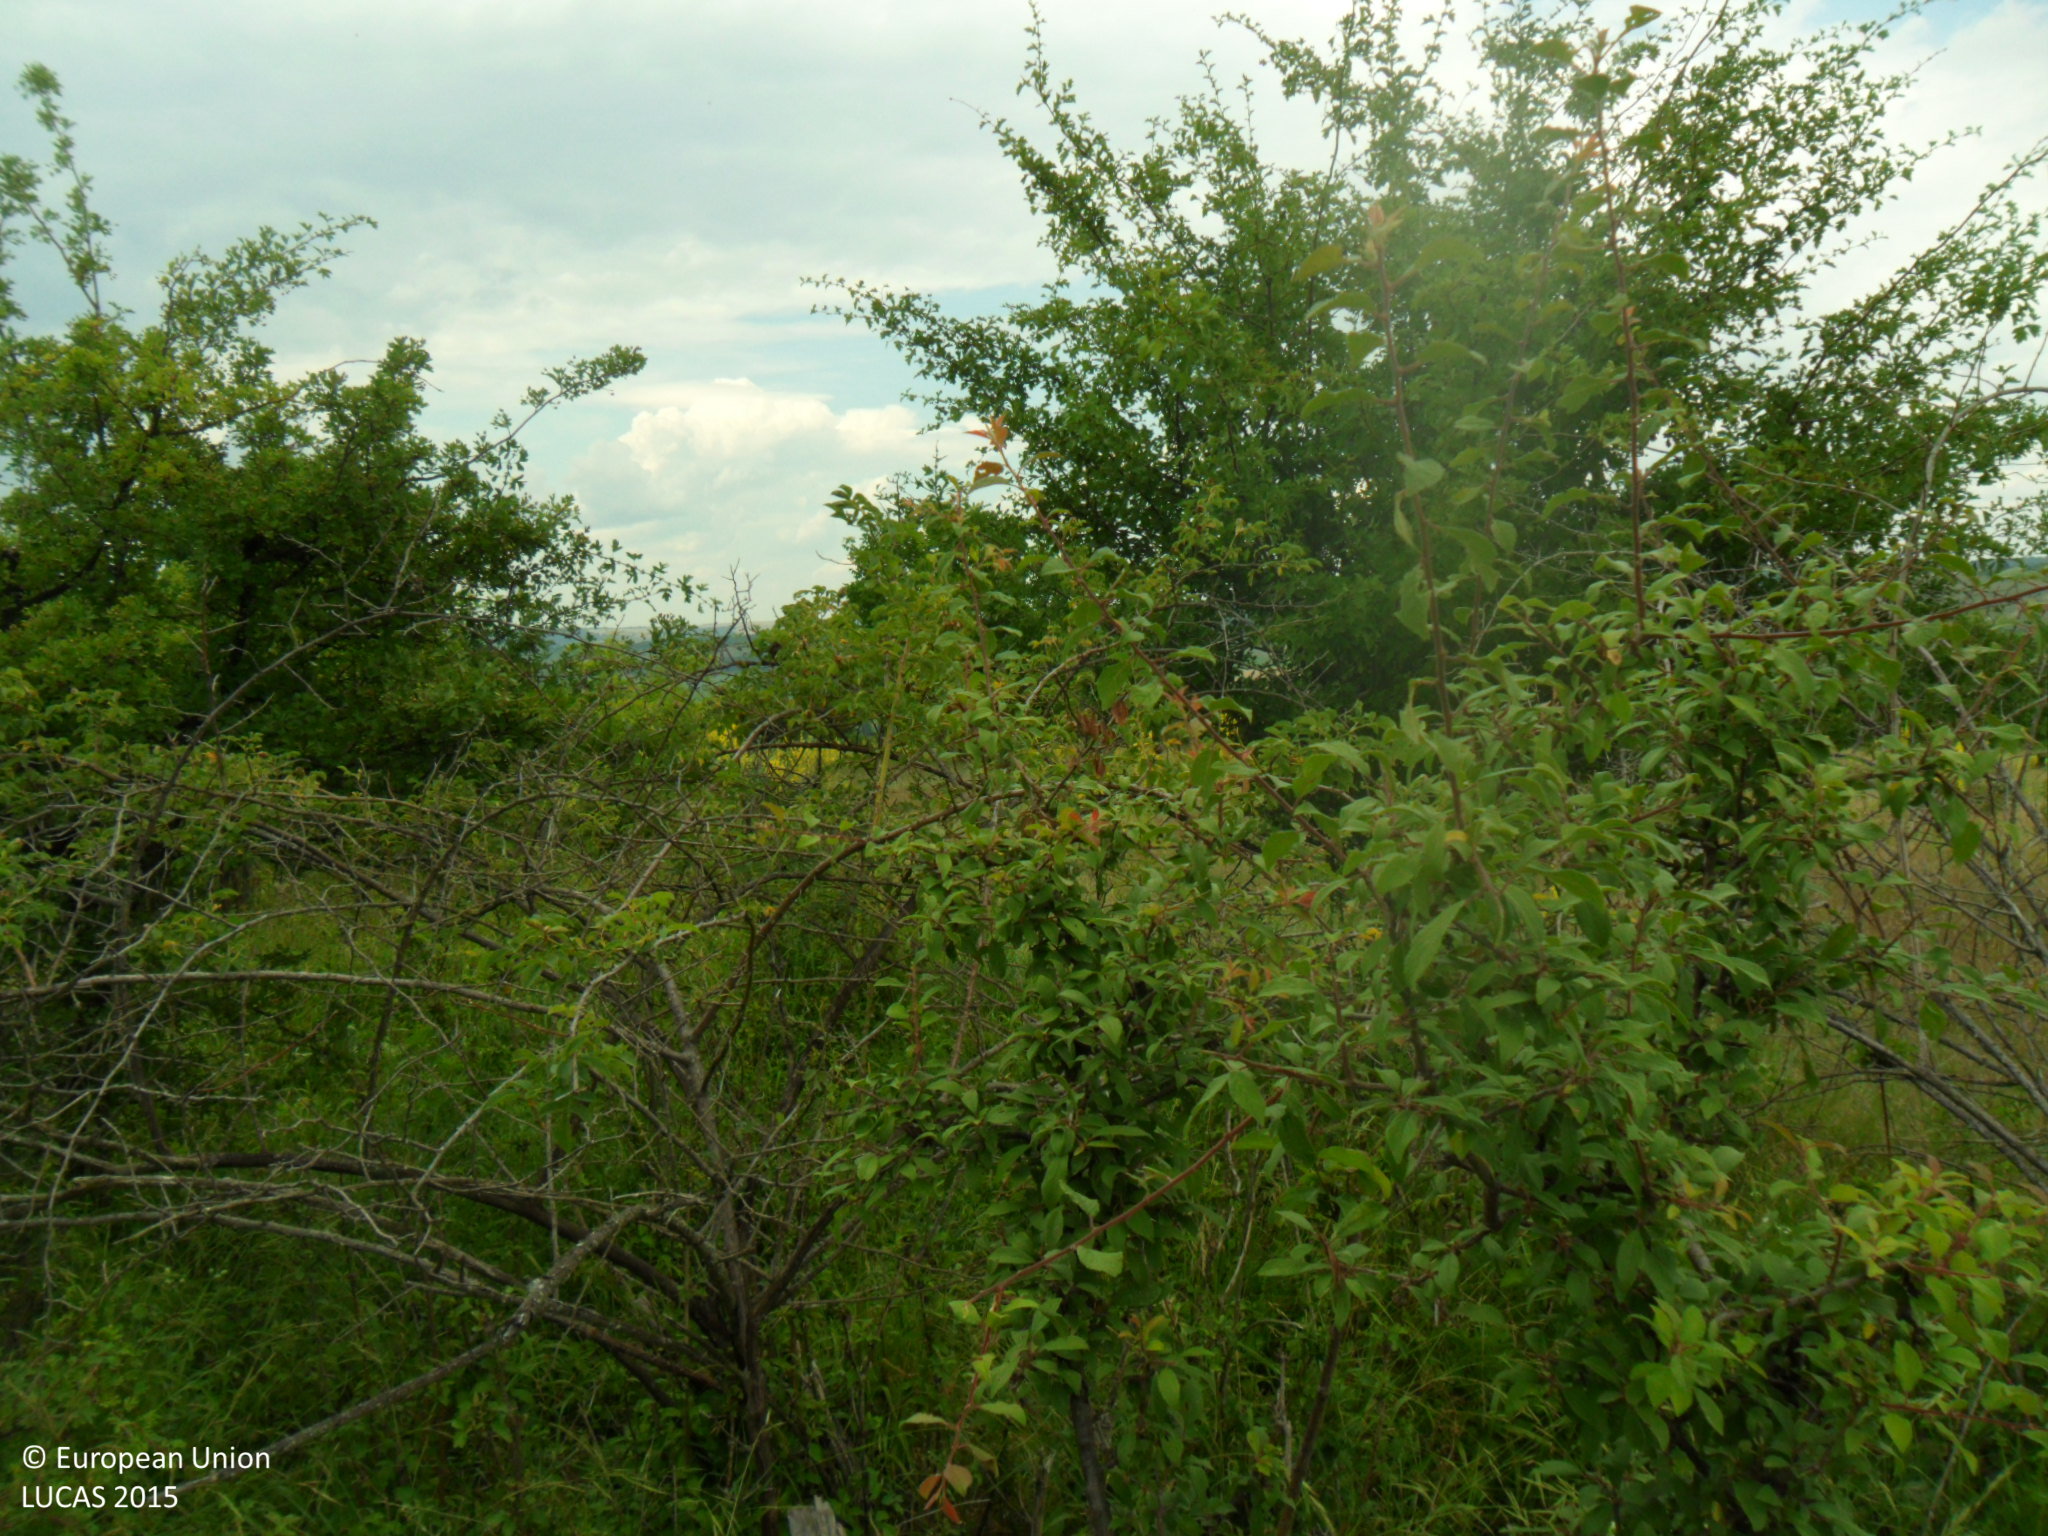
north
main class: Shrubland
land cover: Shrubland with sparse tree cover
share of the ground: > 75 %
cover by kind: herbaceous plants 60 %, shrubs 35 %, broadleaved forest trees 5 %
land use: Agriculture (excluding fallow land and kitchen gardens)
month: June
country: BG
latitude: 43.4567
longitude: 26.6309
